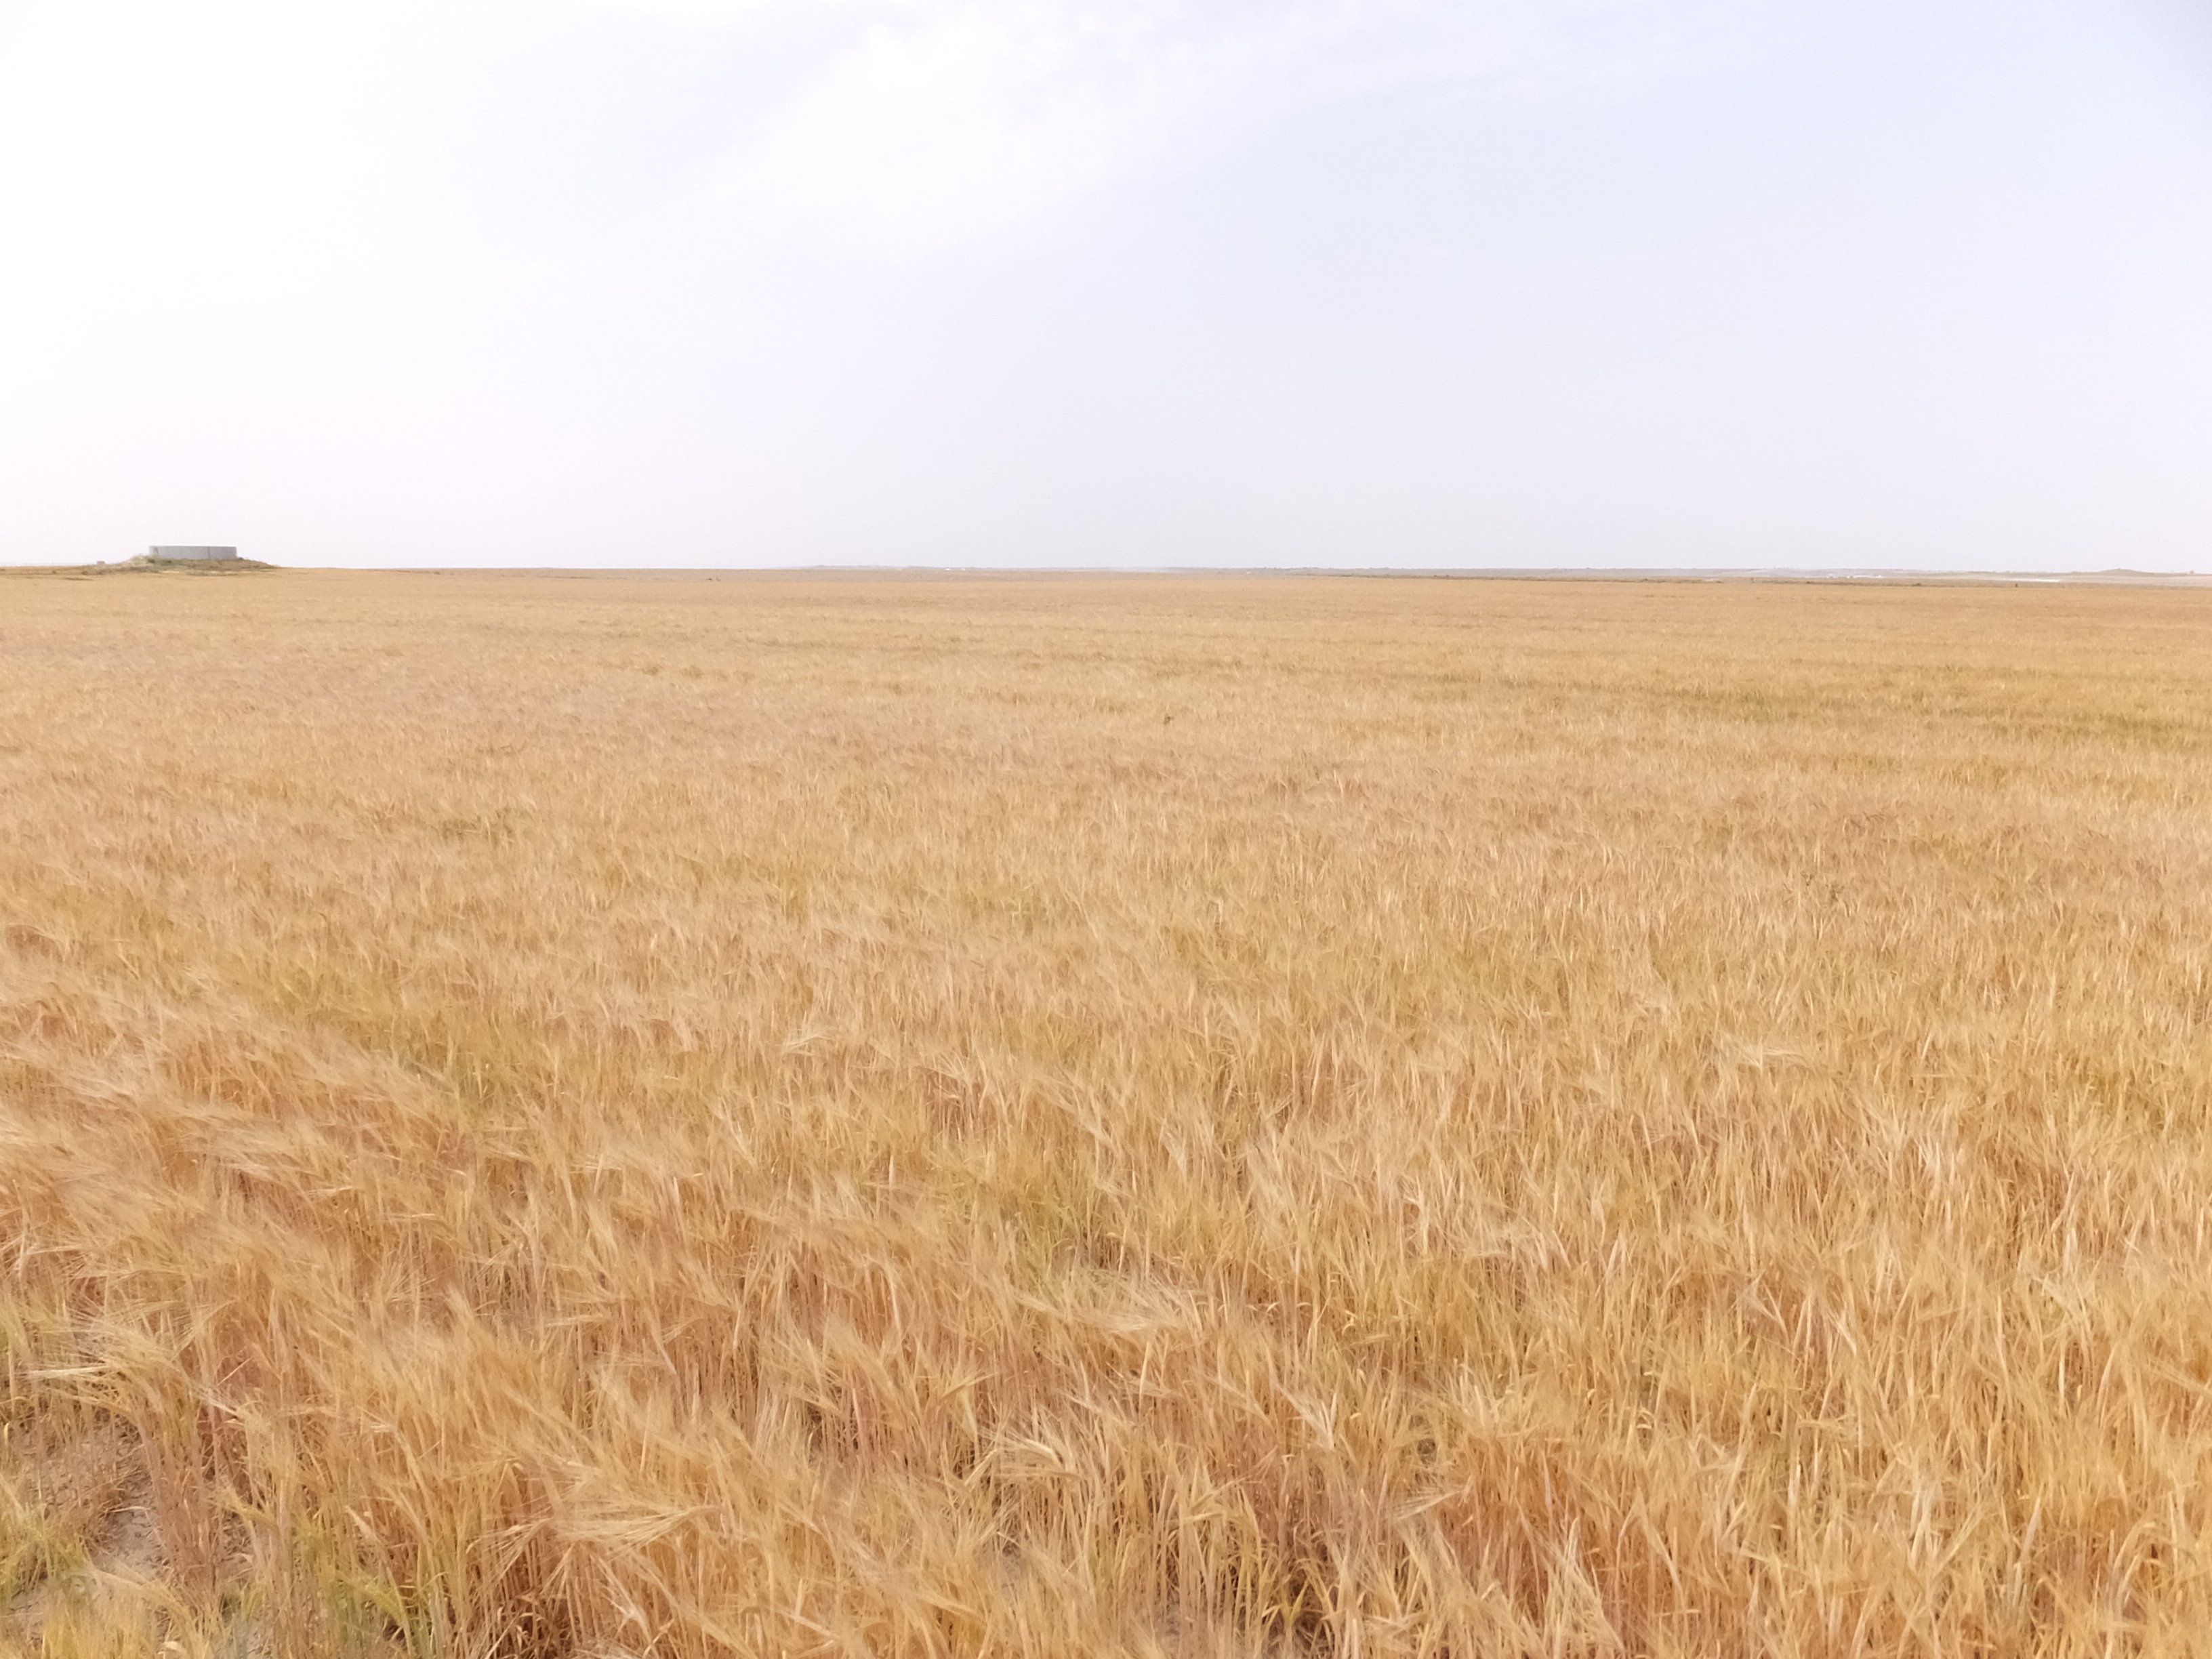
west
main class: Cropland
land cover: Barley
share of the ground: > 75 %
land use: Agriculture (excluding fallow land and kitchen gardens)
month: May
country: ES
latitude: 41.4511
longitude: -0.1540
